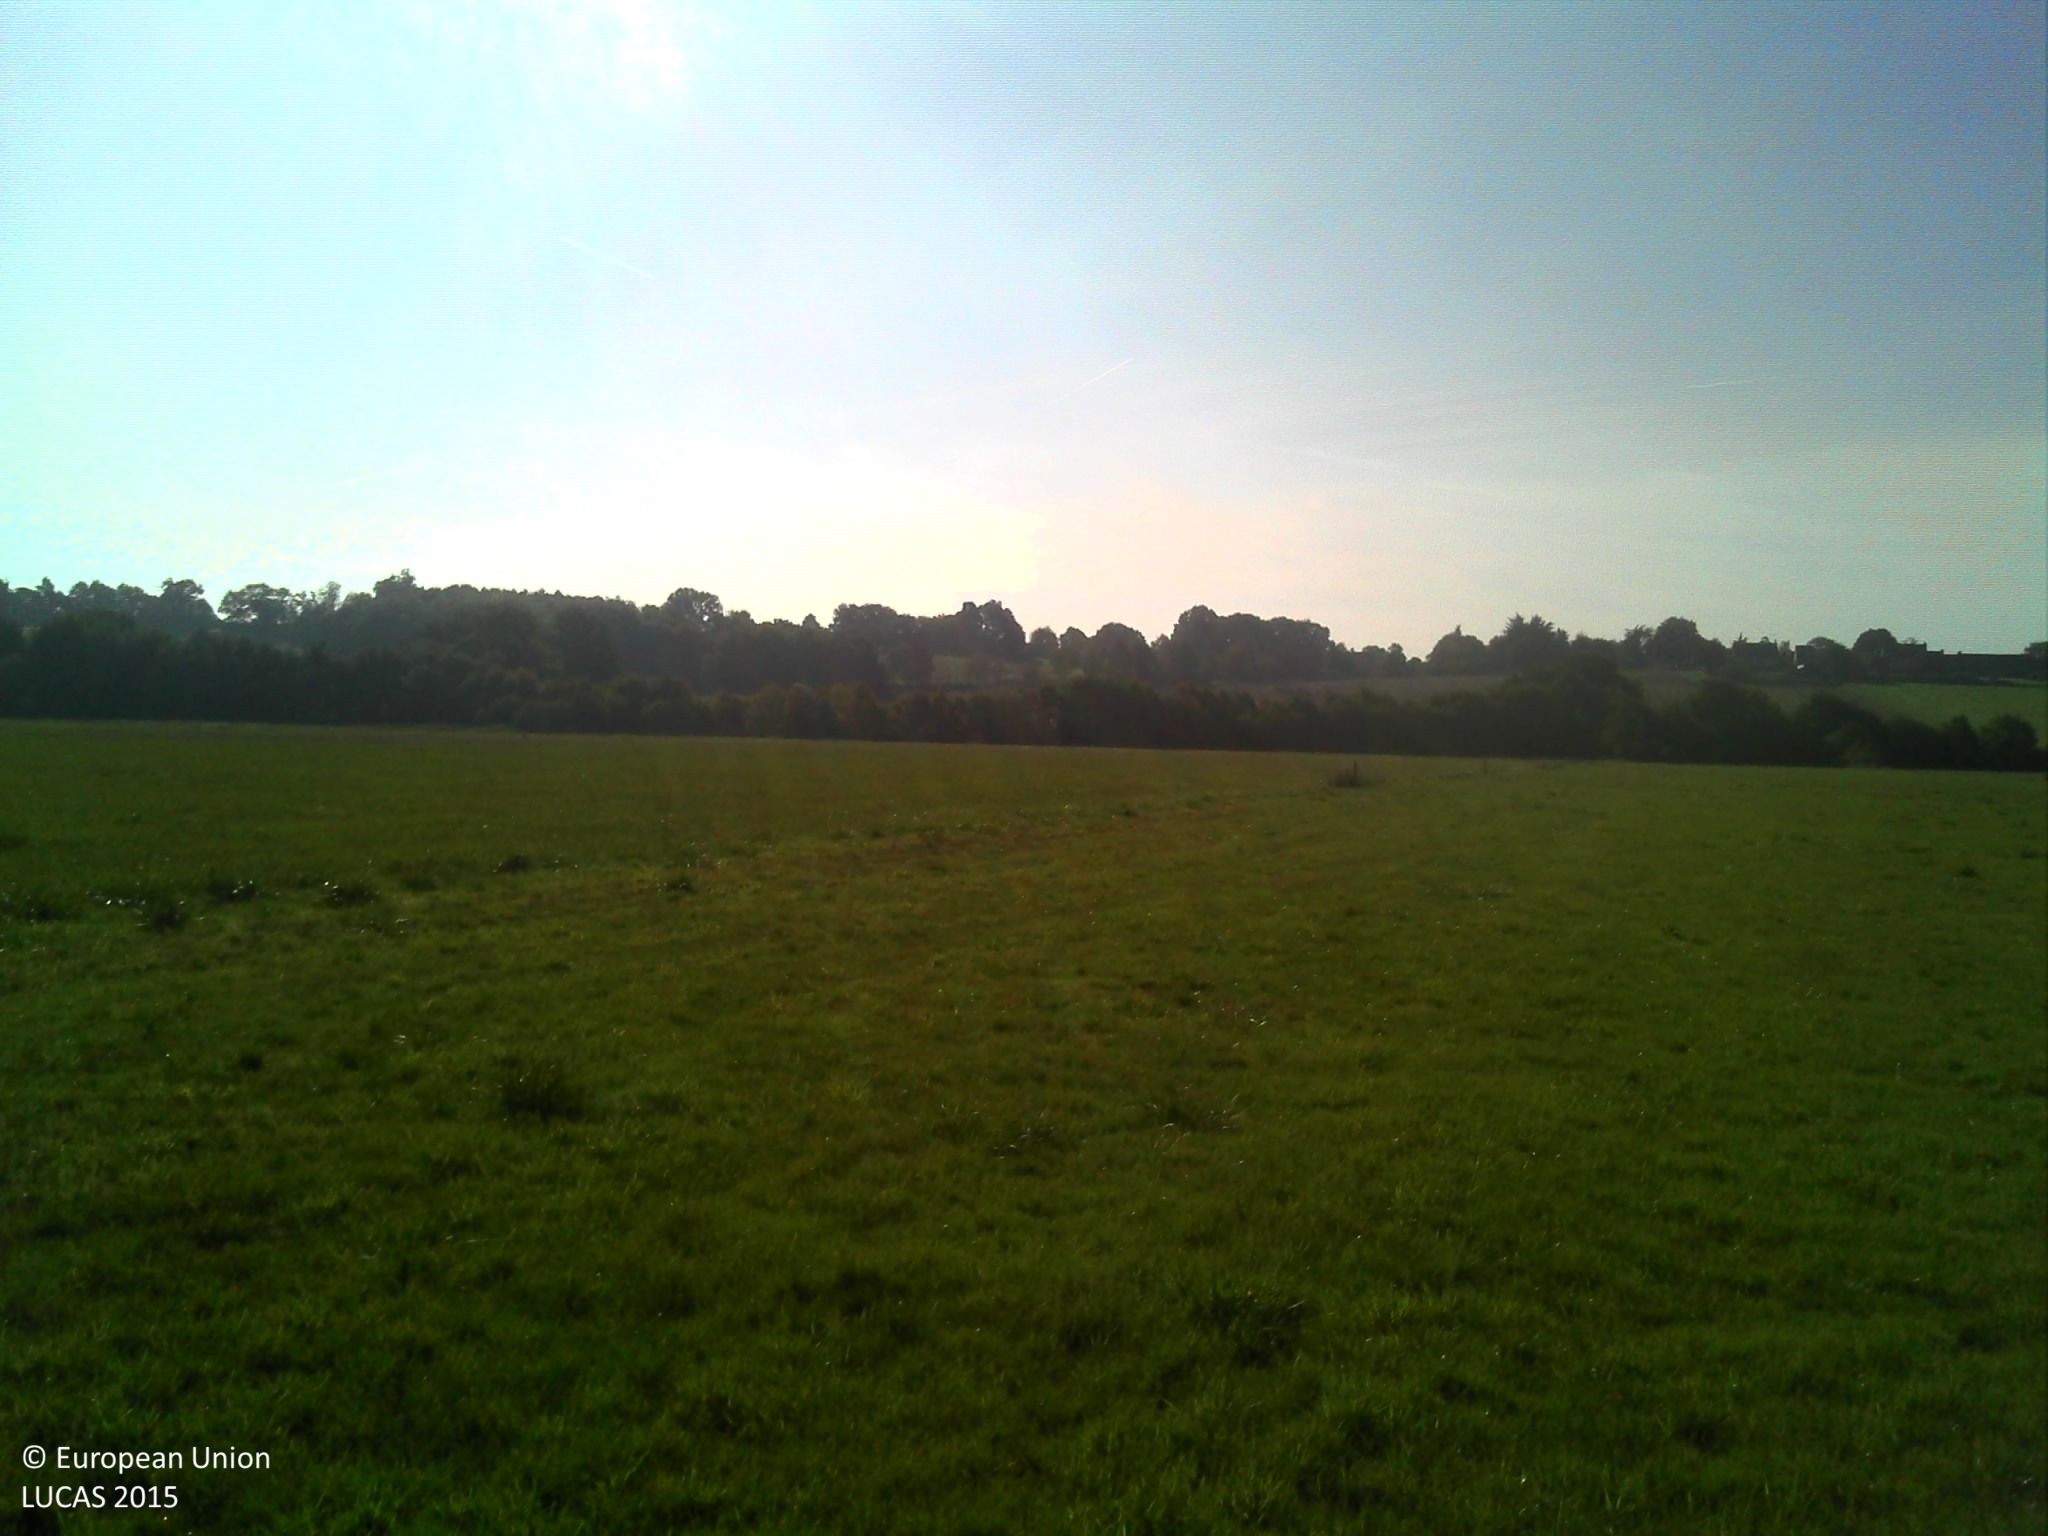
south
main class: Grassland
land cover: Grassland without tree/shrub cover
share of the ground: > 75 %
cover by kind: herbaceous plants 100 %
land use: Agriculture (excluding fallow land and kitchen gardens)
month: October
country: FR
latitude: 47.5833
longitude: -2.1652
